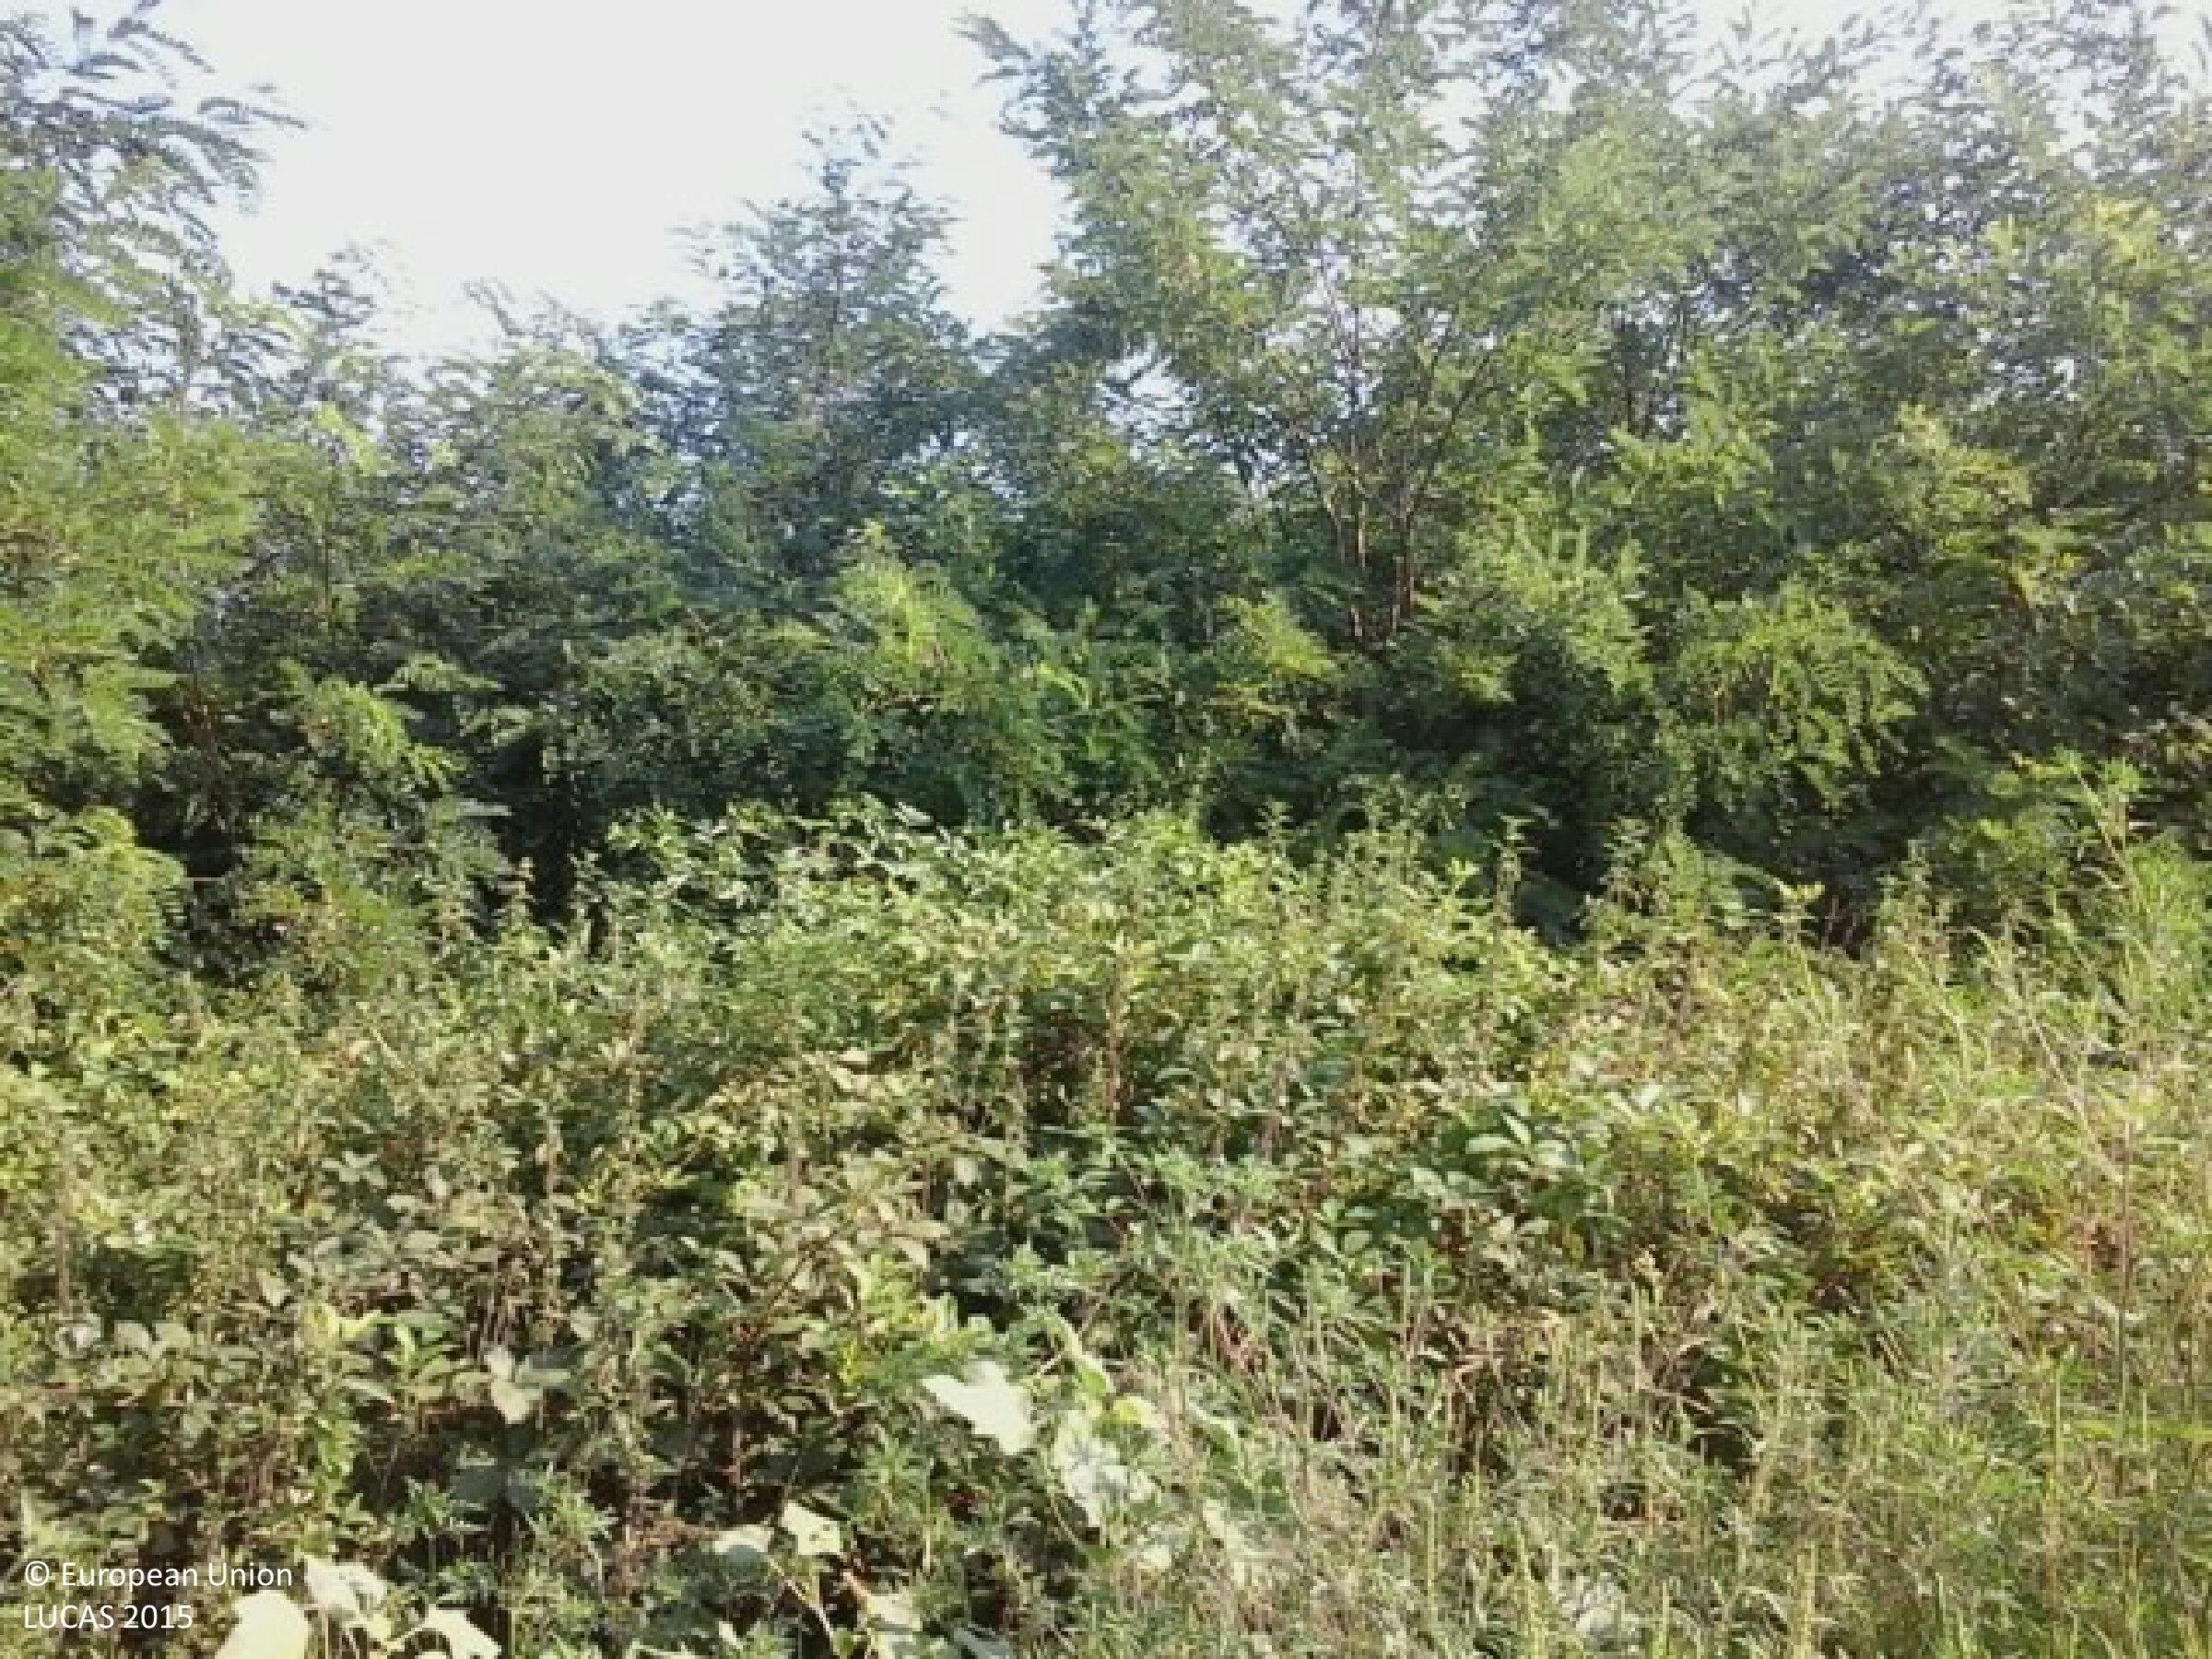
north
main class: Woodland
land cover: Broadleaved woodland
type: exotic forest
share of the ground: > 75 %
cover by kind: shrubs 60 %, broadleaved forest trees 40 %
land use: Abandoned areas
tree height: < 5 m
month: August
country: HU
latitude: 46.2954
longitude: 18.3559
